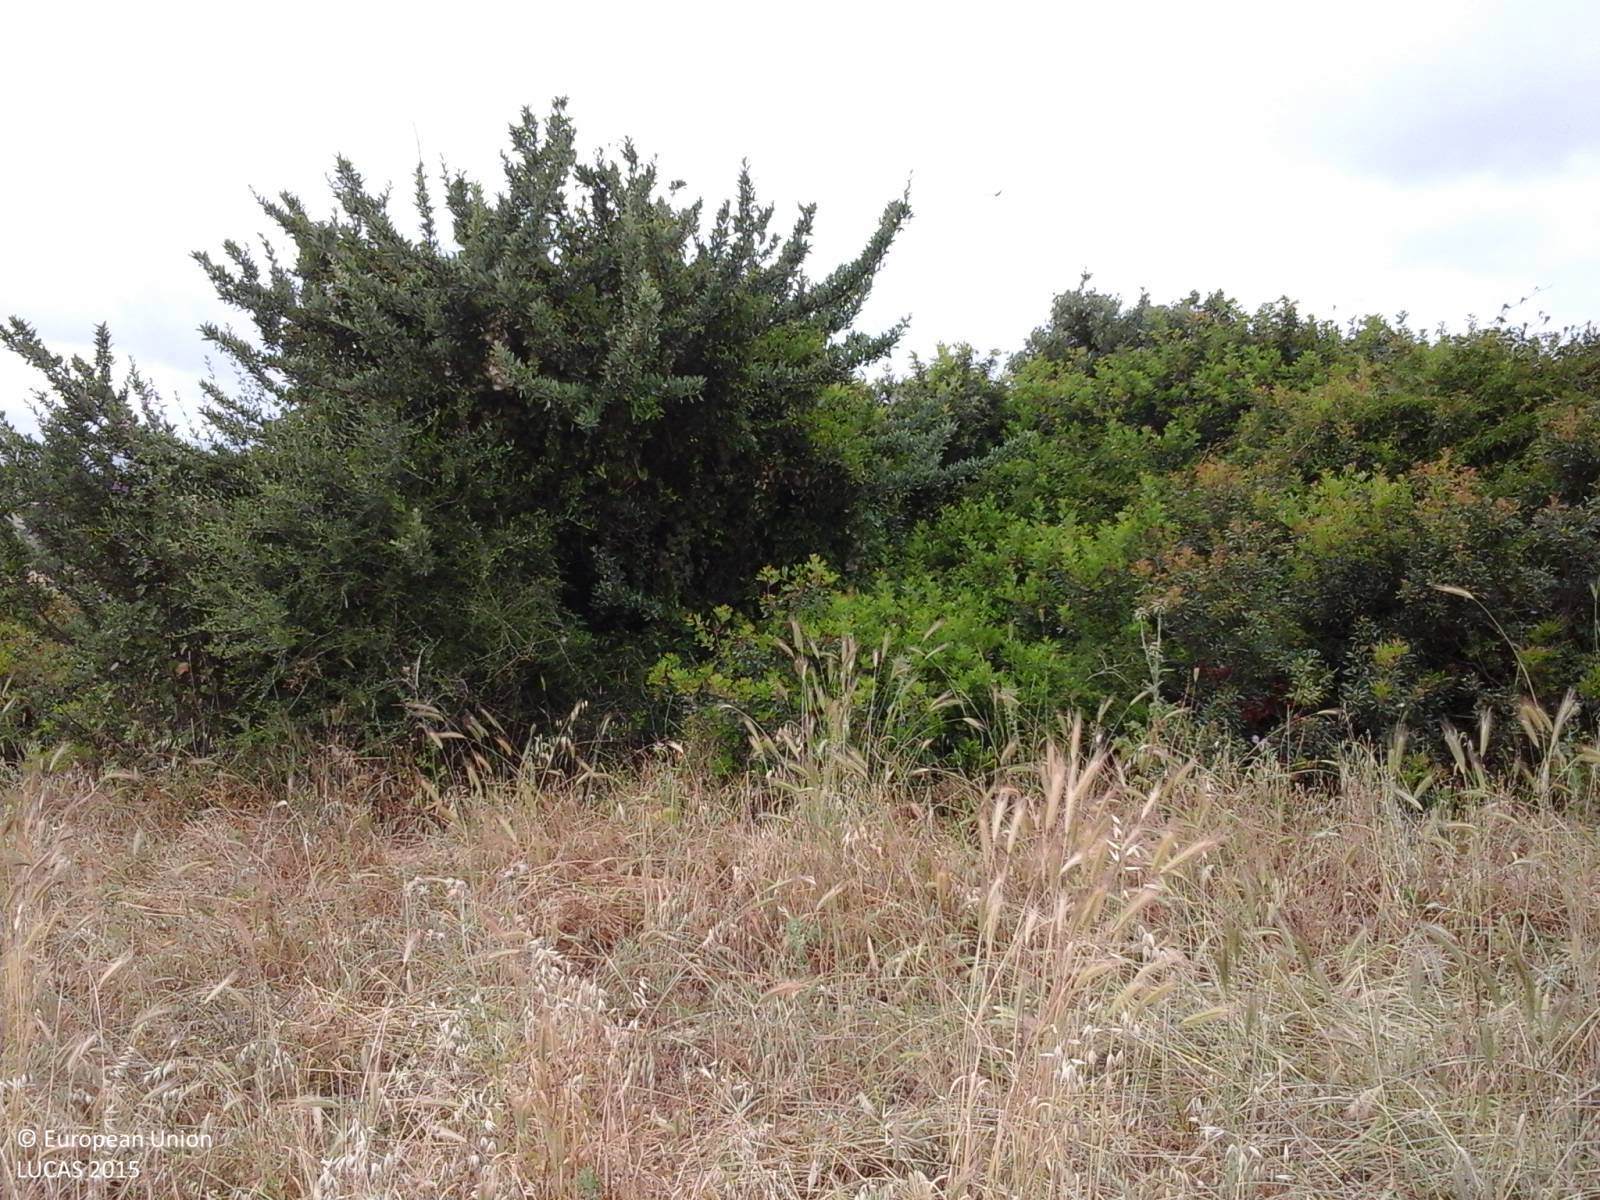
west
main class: Grassland
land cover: Spontaneously vegetated surfaces
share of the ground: > 75 %
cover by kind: herbaceous plants 100 %
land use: Agriculture (excluding fallow land and kitchen gardens)
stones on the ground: 25 - 50 %
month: May
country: IT
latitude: 39.8625
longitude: 8.8724
